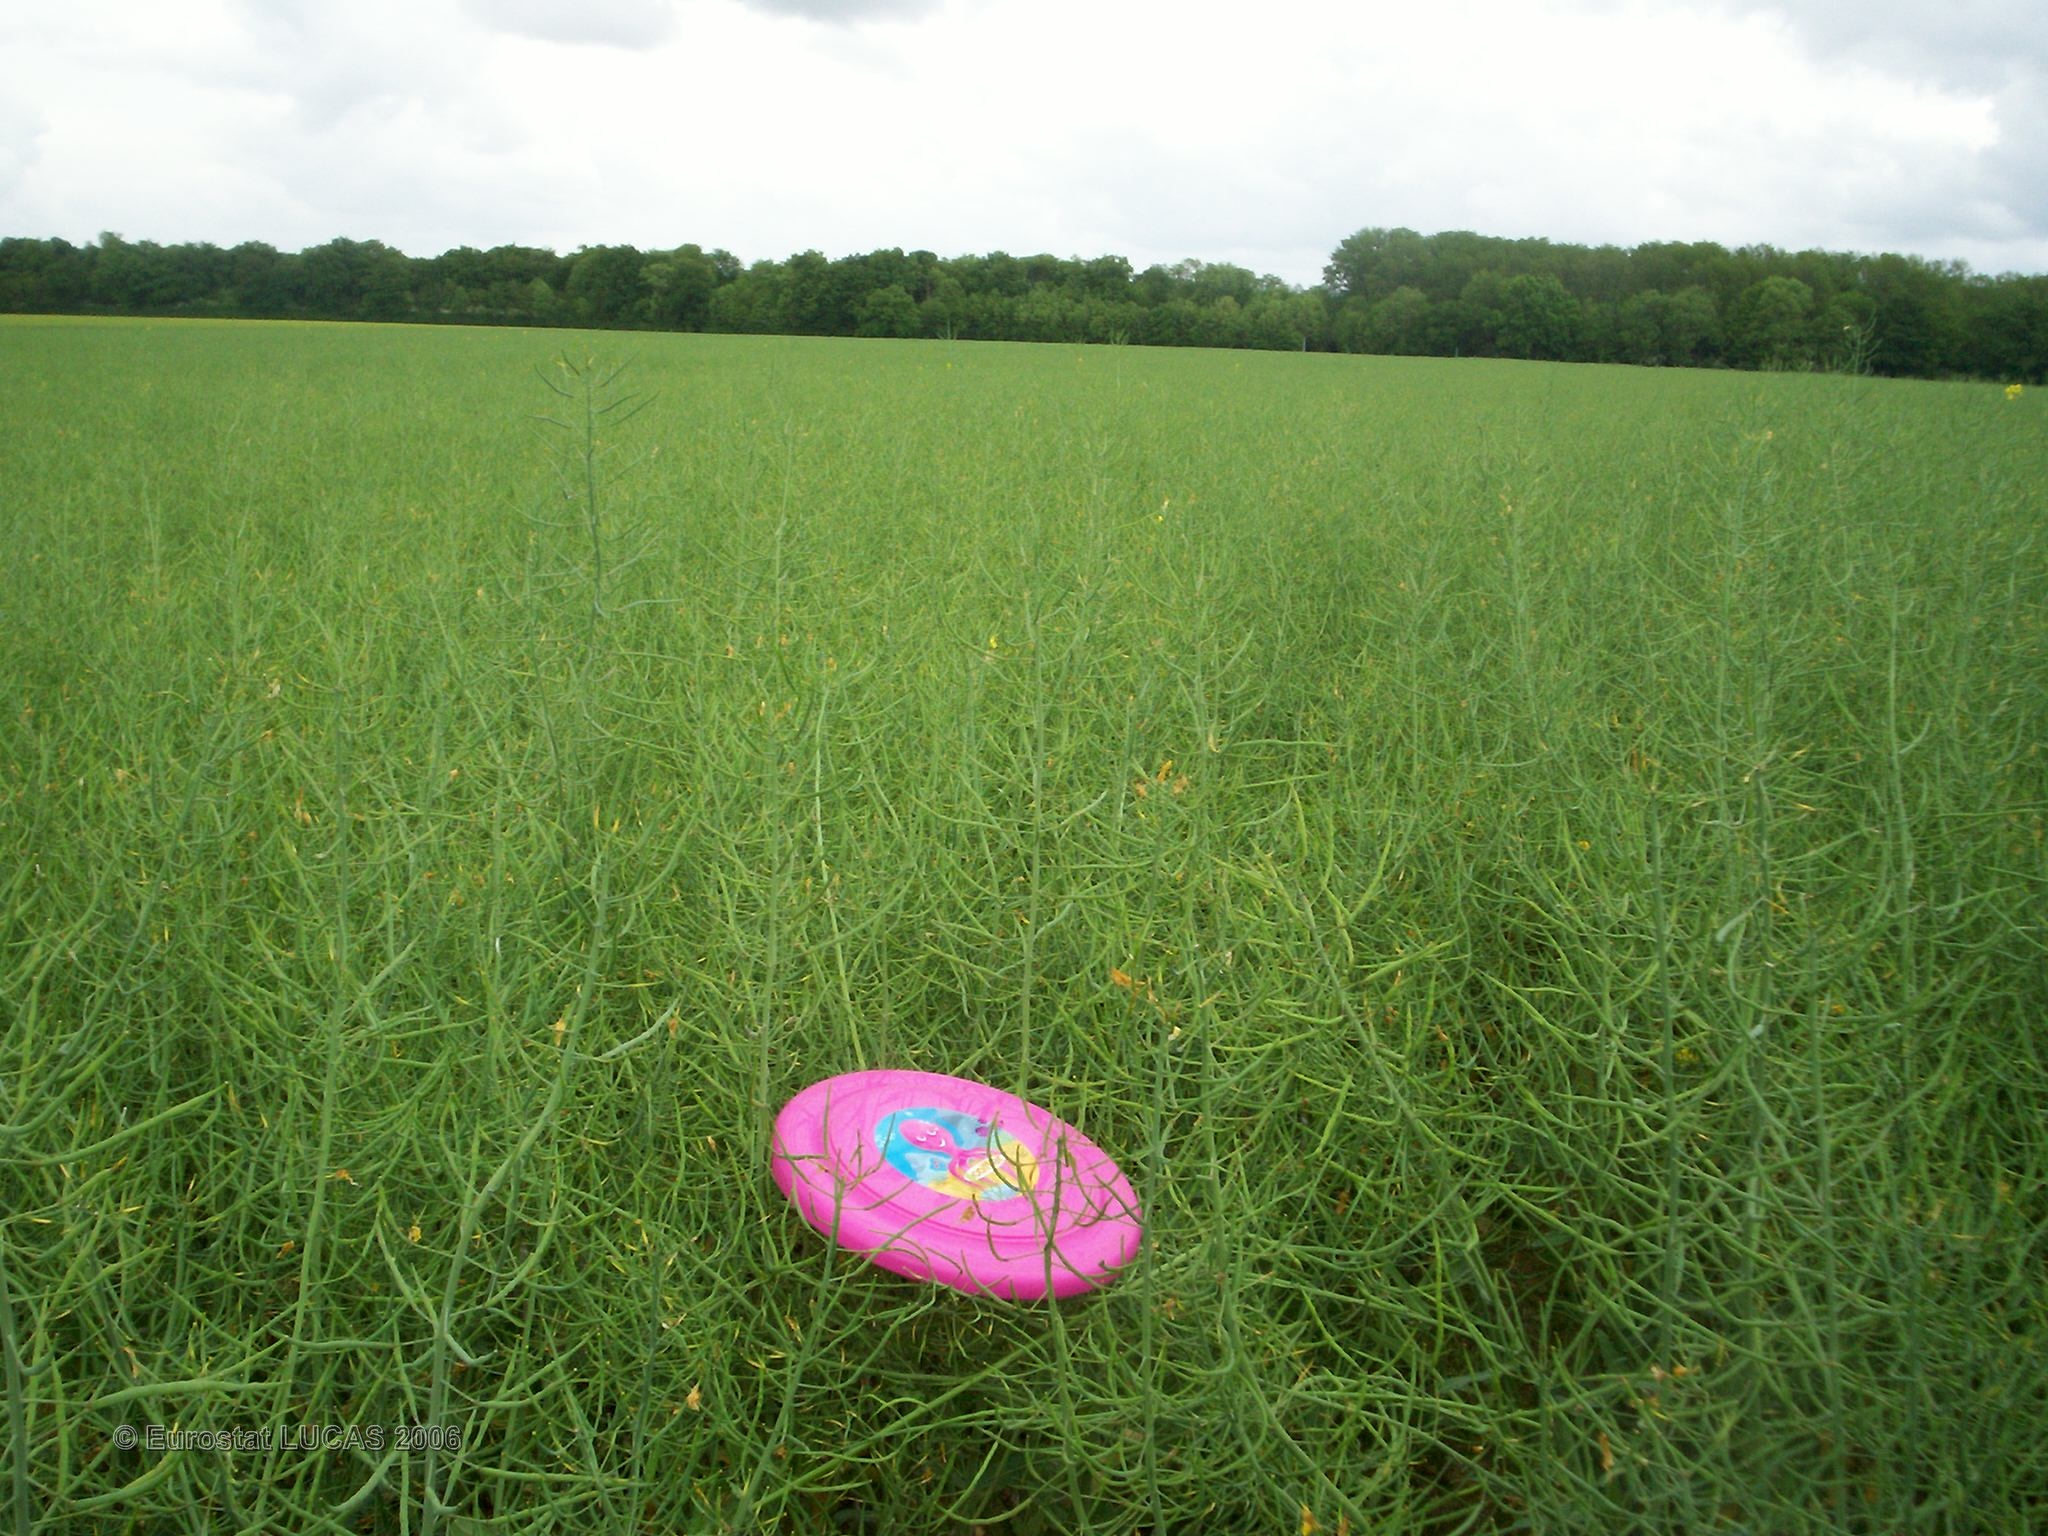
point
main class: Cropland
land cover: Rape and turnip rape
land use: Agriculture (excluding fallow land and kitchen gardens)
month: May
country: FR
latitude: 47.7833
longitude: 2.9863
